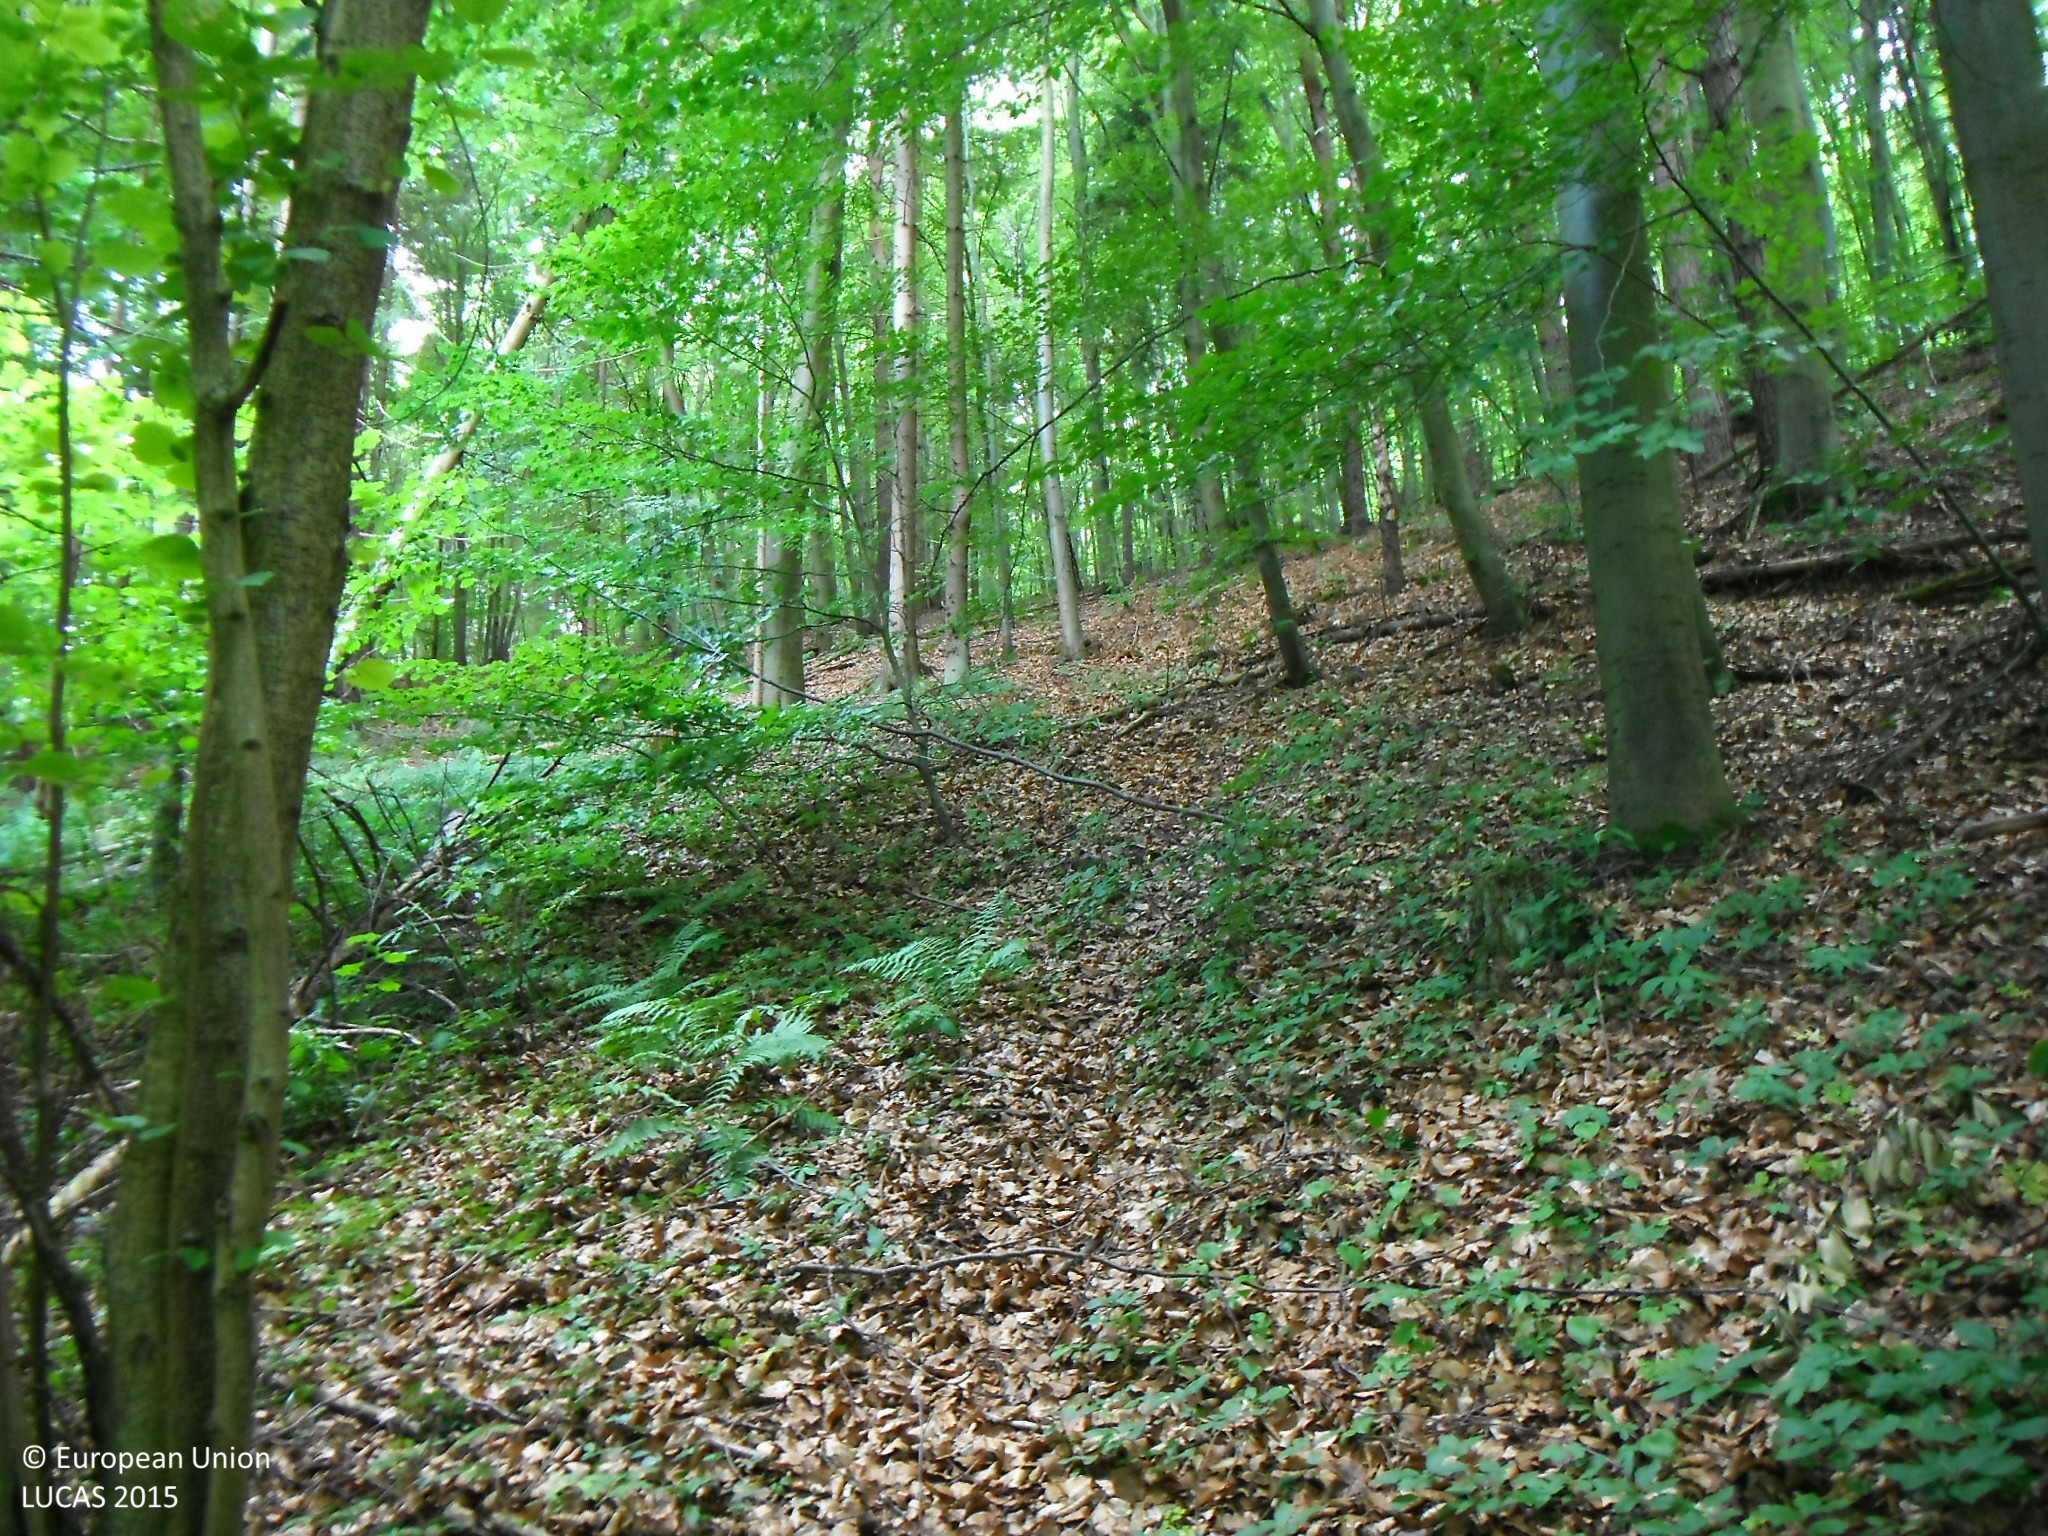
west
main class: Woodland
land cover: Other mixed woodland
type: hemiboreal forest and nemoral coniferous forest and mixed broadleaved-coniferous forest
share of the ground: > 75 %
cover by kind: broadleaved forest trees 60 %, coniferous forest trees 40 %
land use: Forestry
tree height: > 5 m
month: June
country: SK
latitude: 48.8982
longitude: 21.0783
